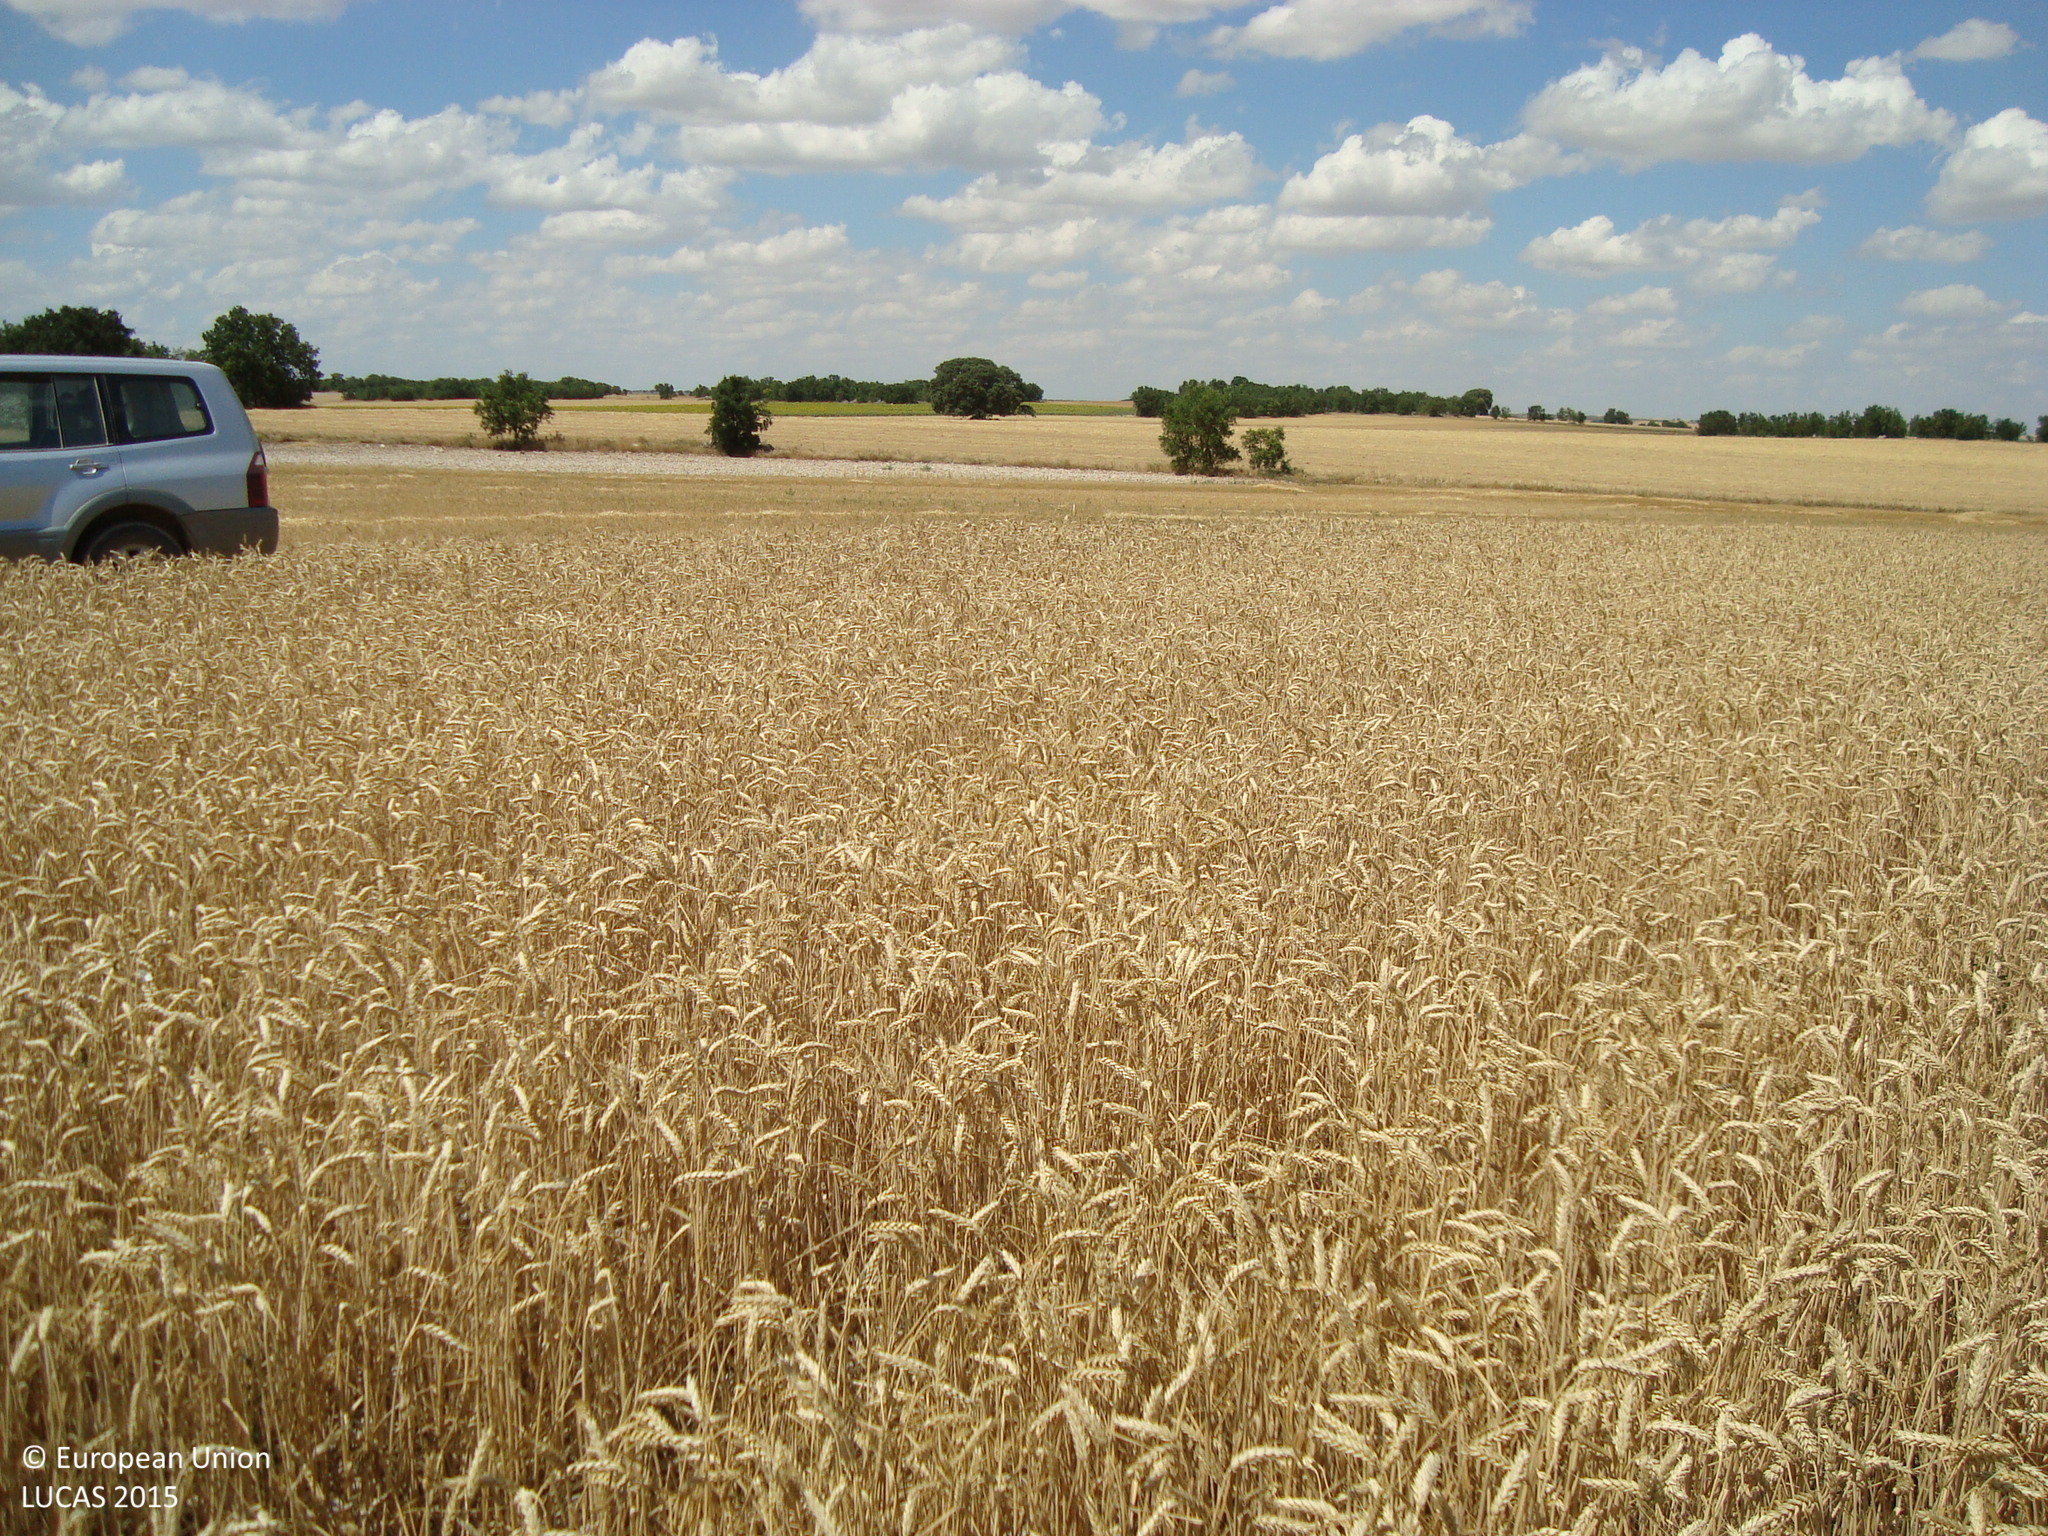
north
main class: Cropland
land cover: Common wheat
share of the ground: > 75 %
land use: Agriculture (excluding fallow land and kitchen gardens)
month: July
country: ES
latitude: 41.7433
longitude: -4.0436
